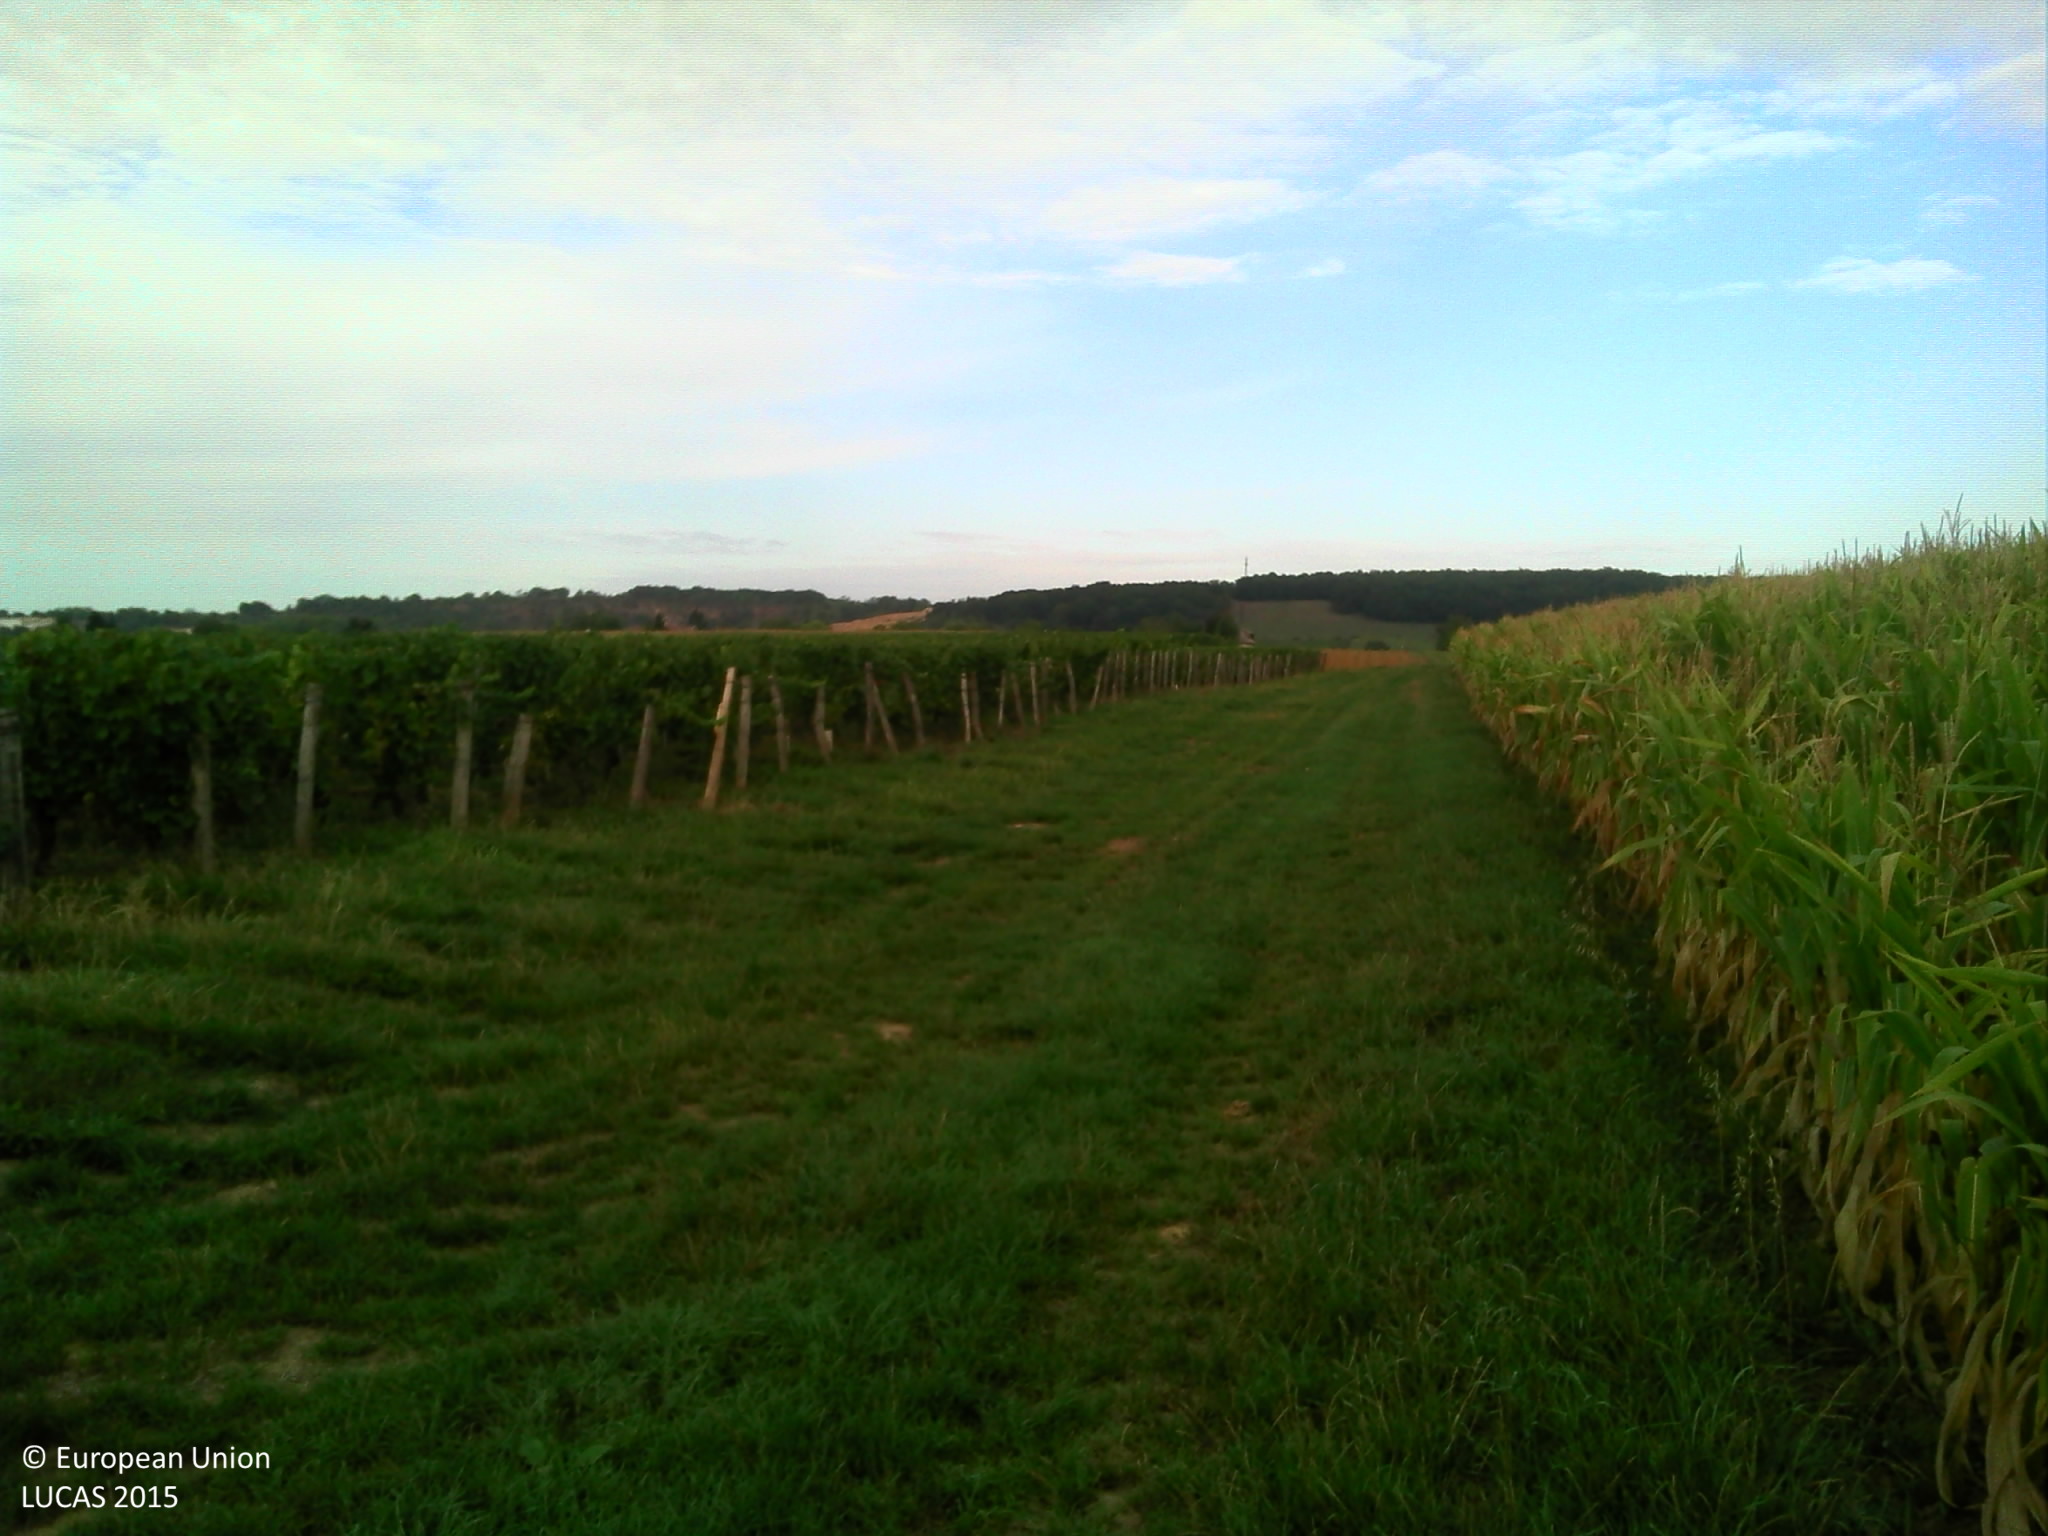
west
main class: Cropland
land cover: Maize
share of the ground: > 75 %
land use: Agriculture (excluding fallow land and kitchen gardens)
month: August
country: FR
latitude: 46.3903
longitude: 4.8655
